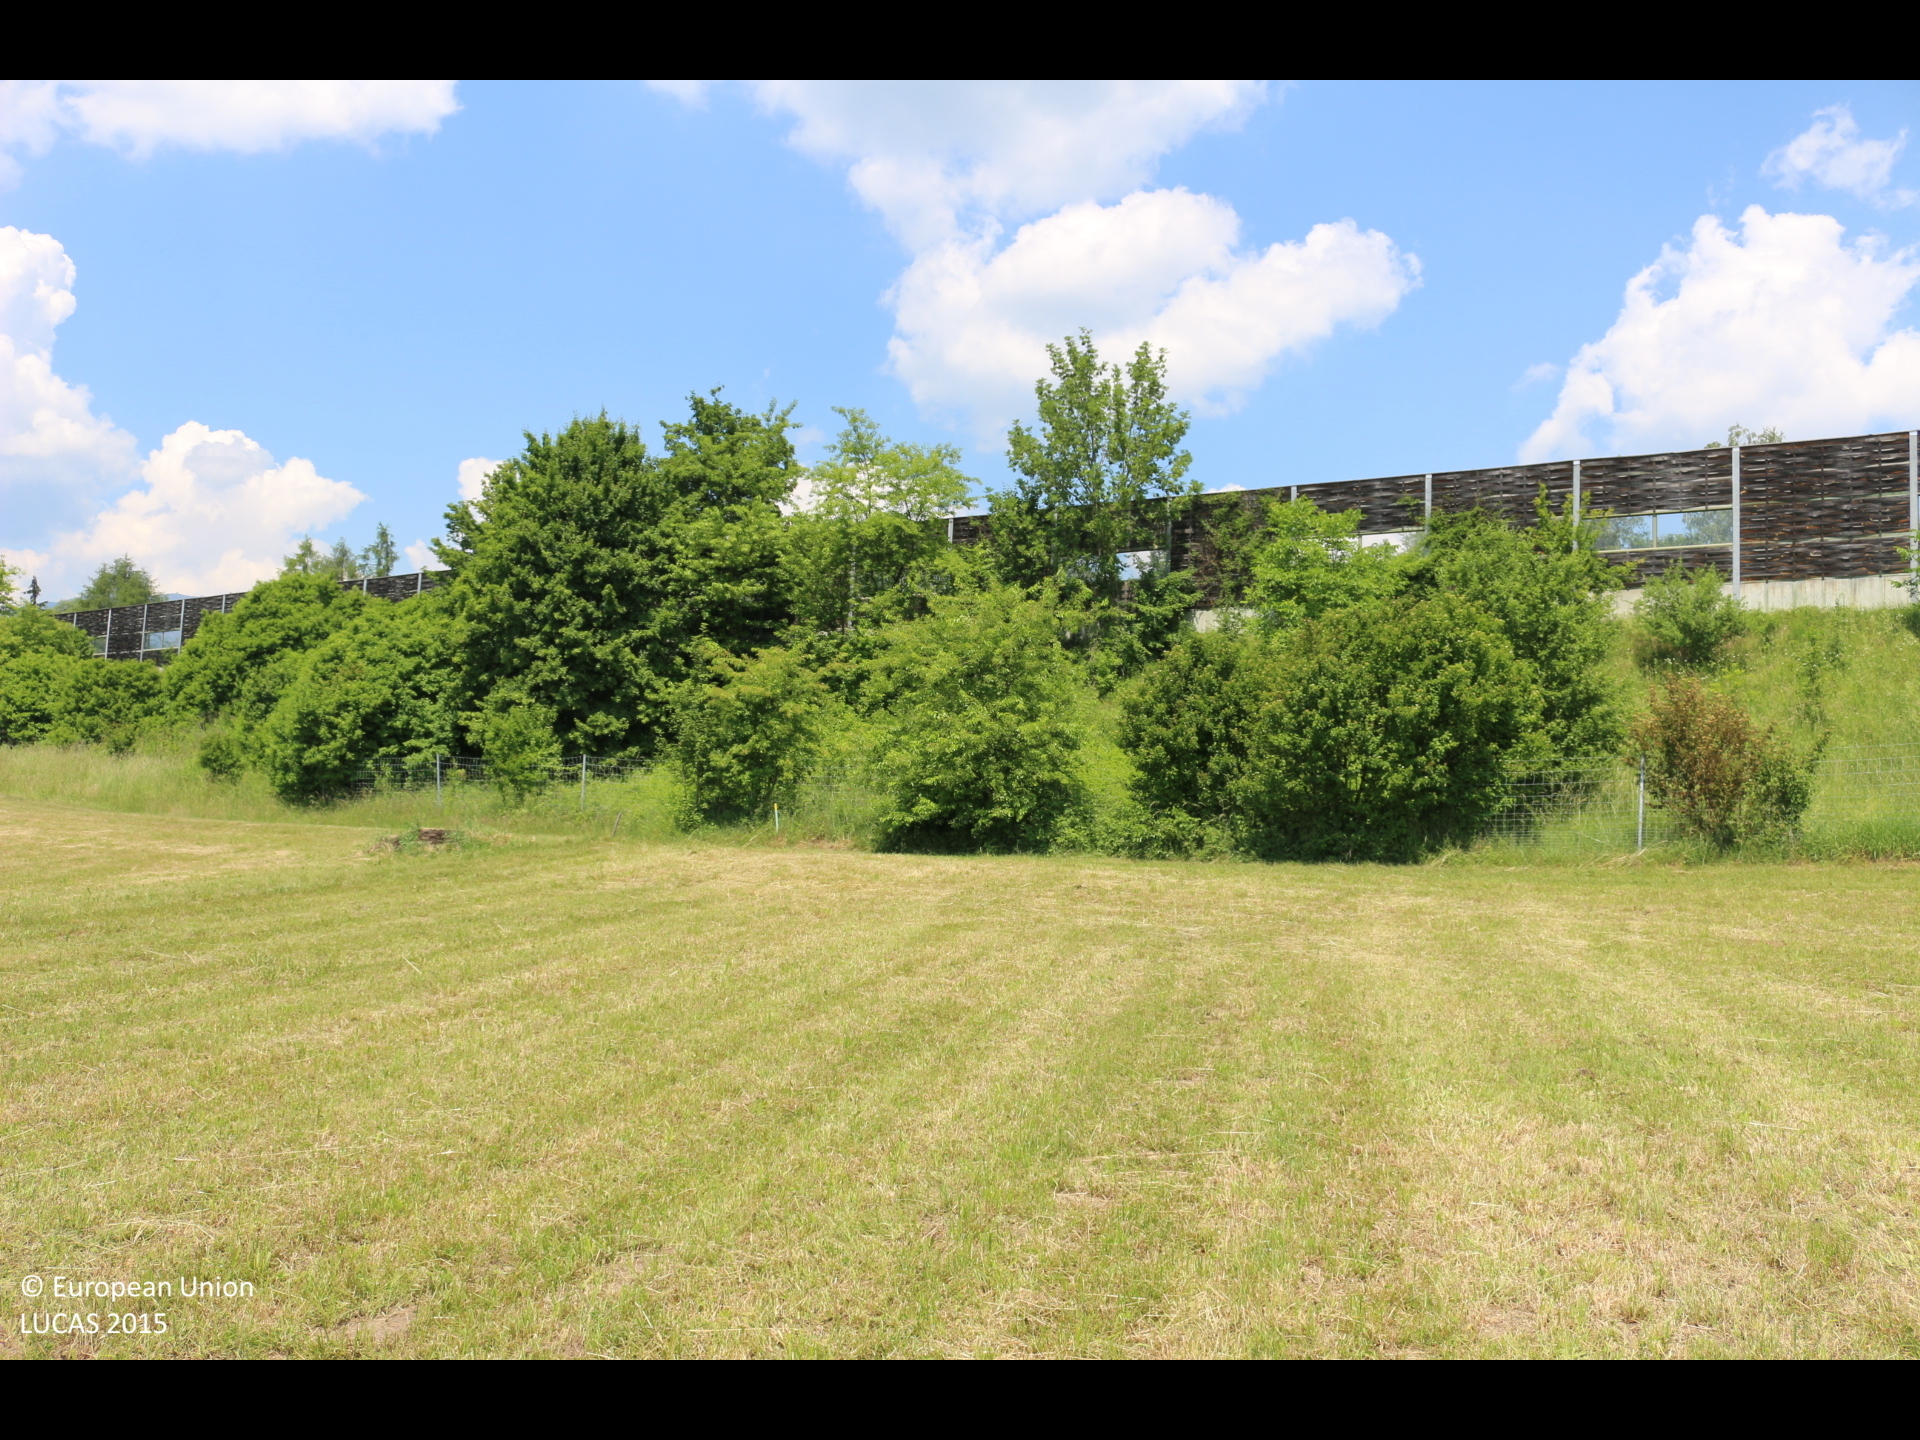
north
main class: Grassland
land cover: Grassland without tree/shrub cover
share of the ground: > 75 %
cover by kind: herbaceous plants 100 %
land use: Agriculture (excluding fallow land and kitchen gardens)
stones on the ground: < 10 %
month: June
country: AT
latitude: 46.6198
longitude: 13.9802
